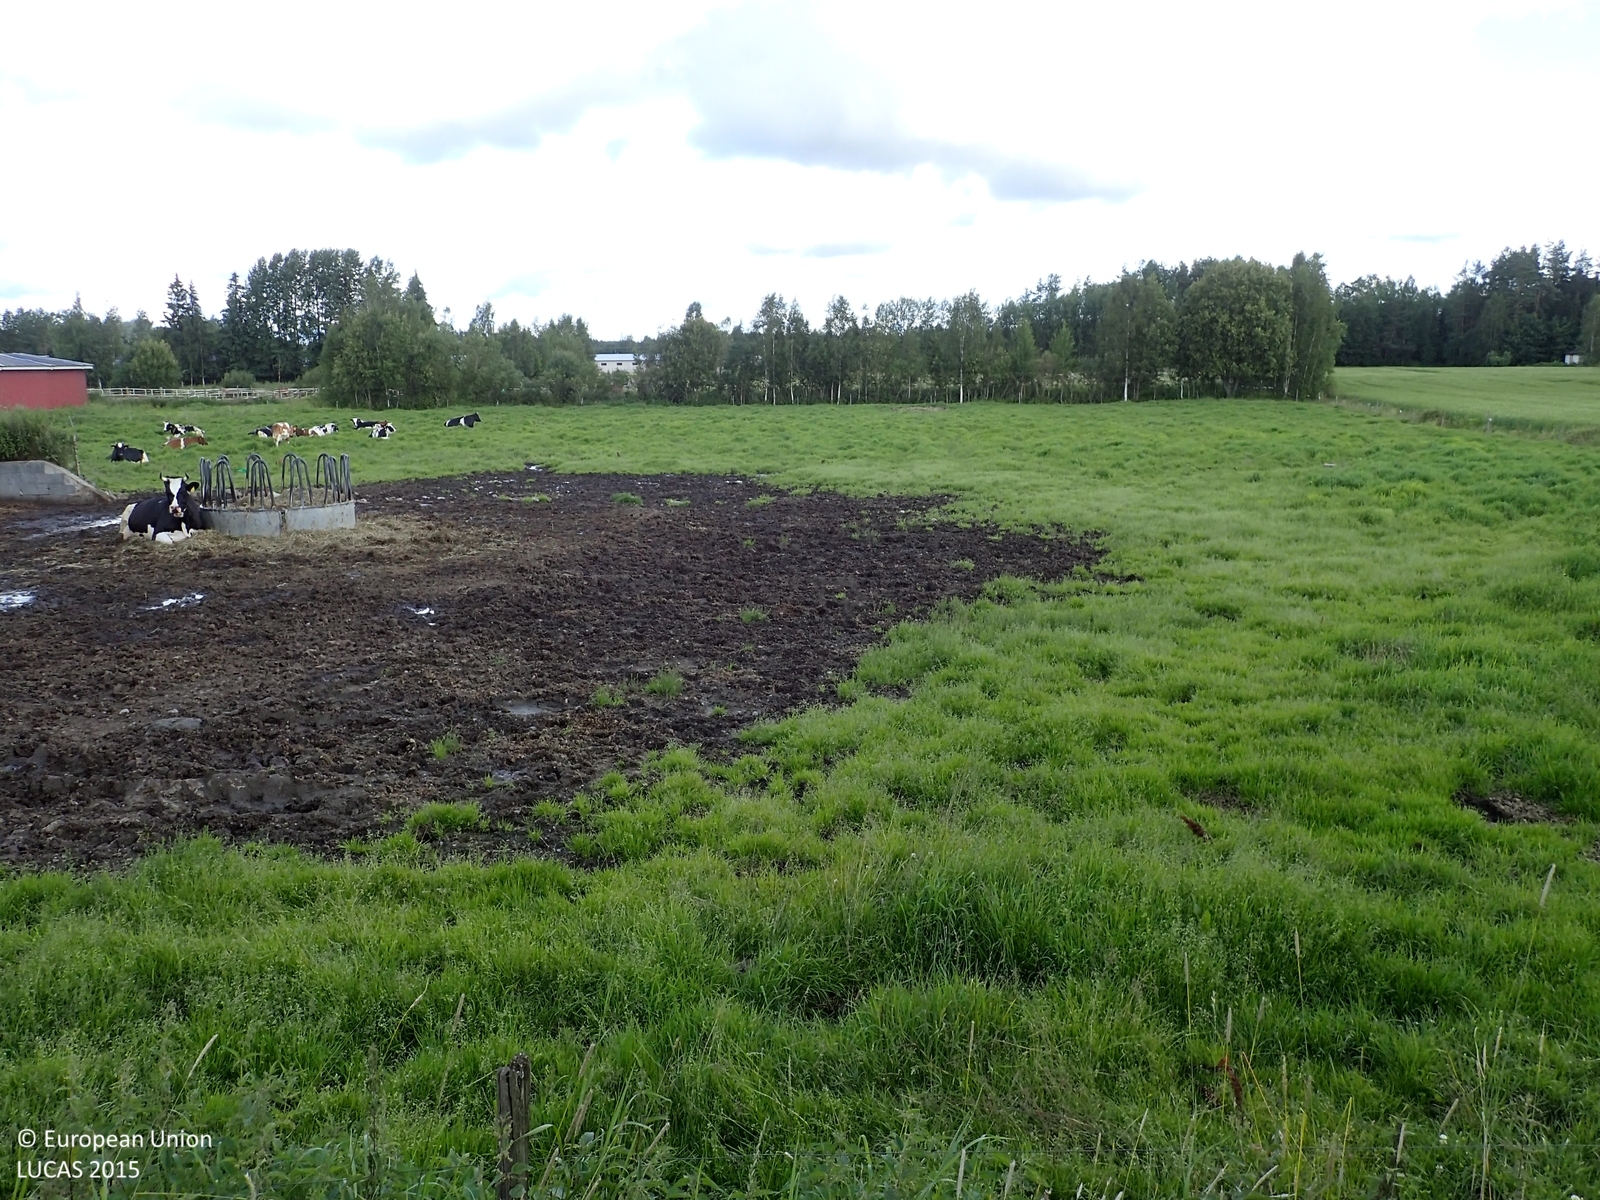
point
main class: Cropland
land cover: Temporary grasslands
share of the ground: > 75 %
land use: Agriculture (excluding fallow land and kitchen gardens)
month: August
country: FI
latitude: 62.7220
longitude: 21.9181
